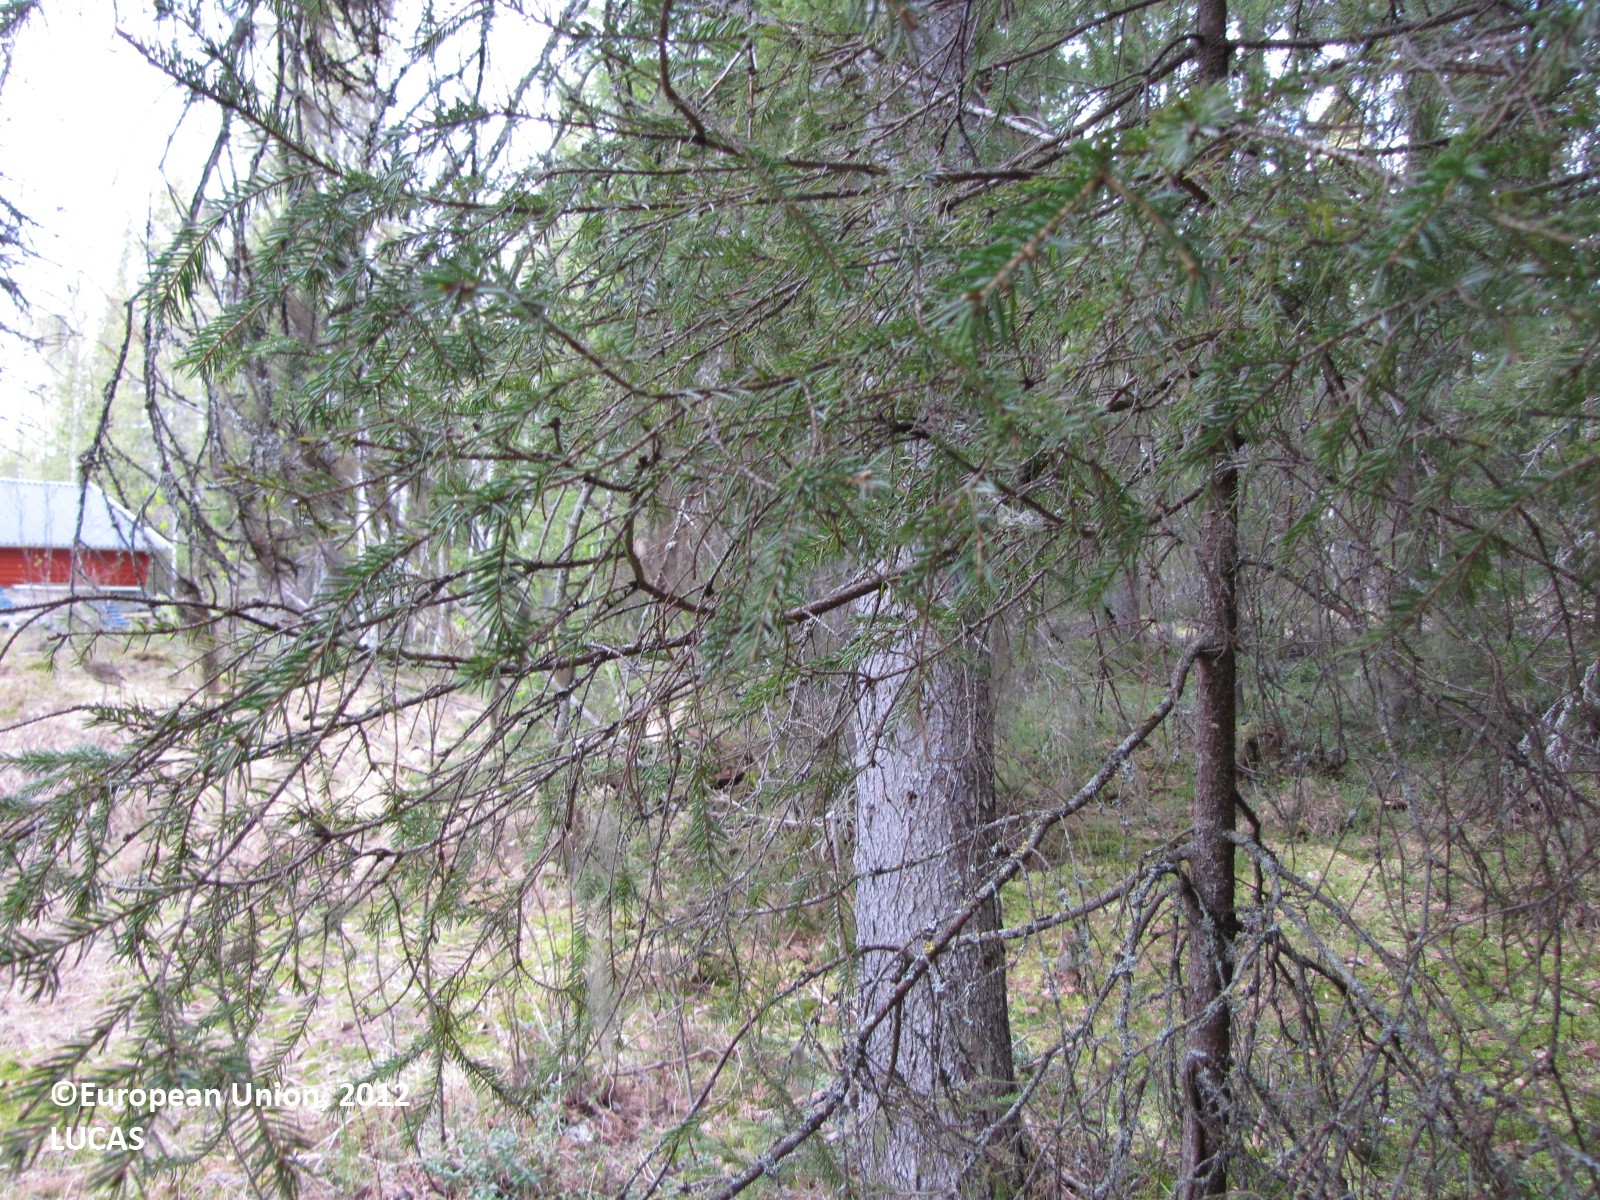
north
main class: Woodland
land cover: Spruce dominated mixed woodland
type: boreal forest
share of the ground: 50 - 75 %
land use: Forestry
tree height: > 5 m
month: June
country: FI
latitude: 65.8173
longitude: 24.6481
